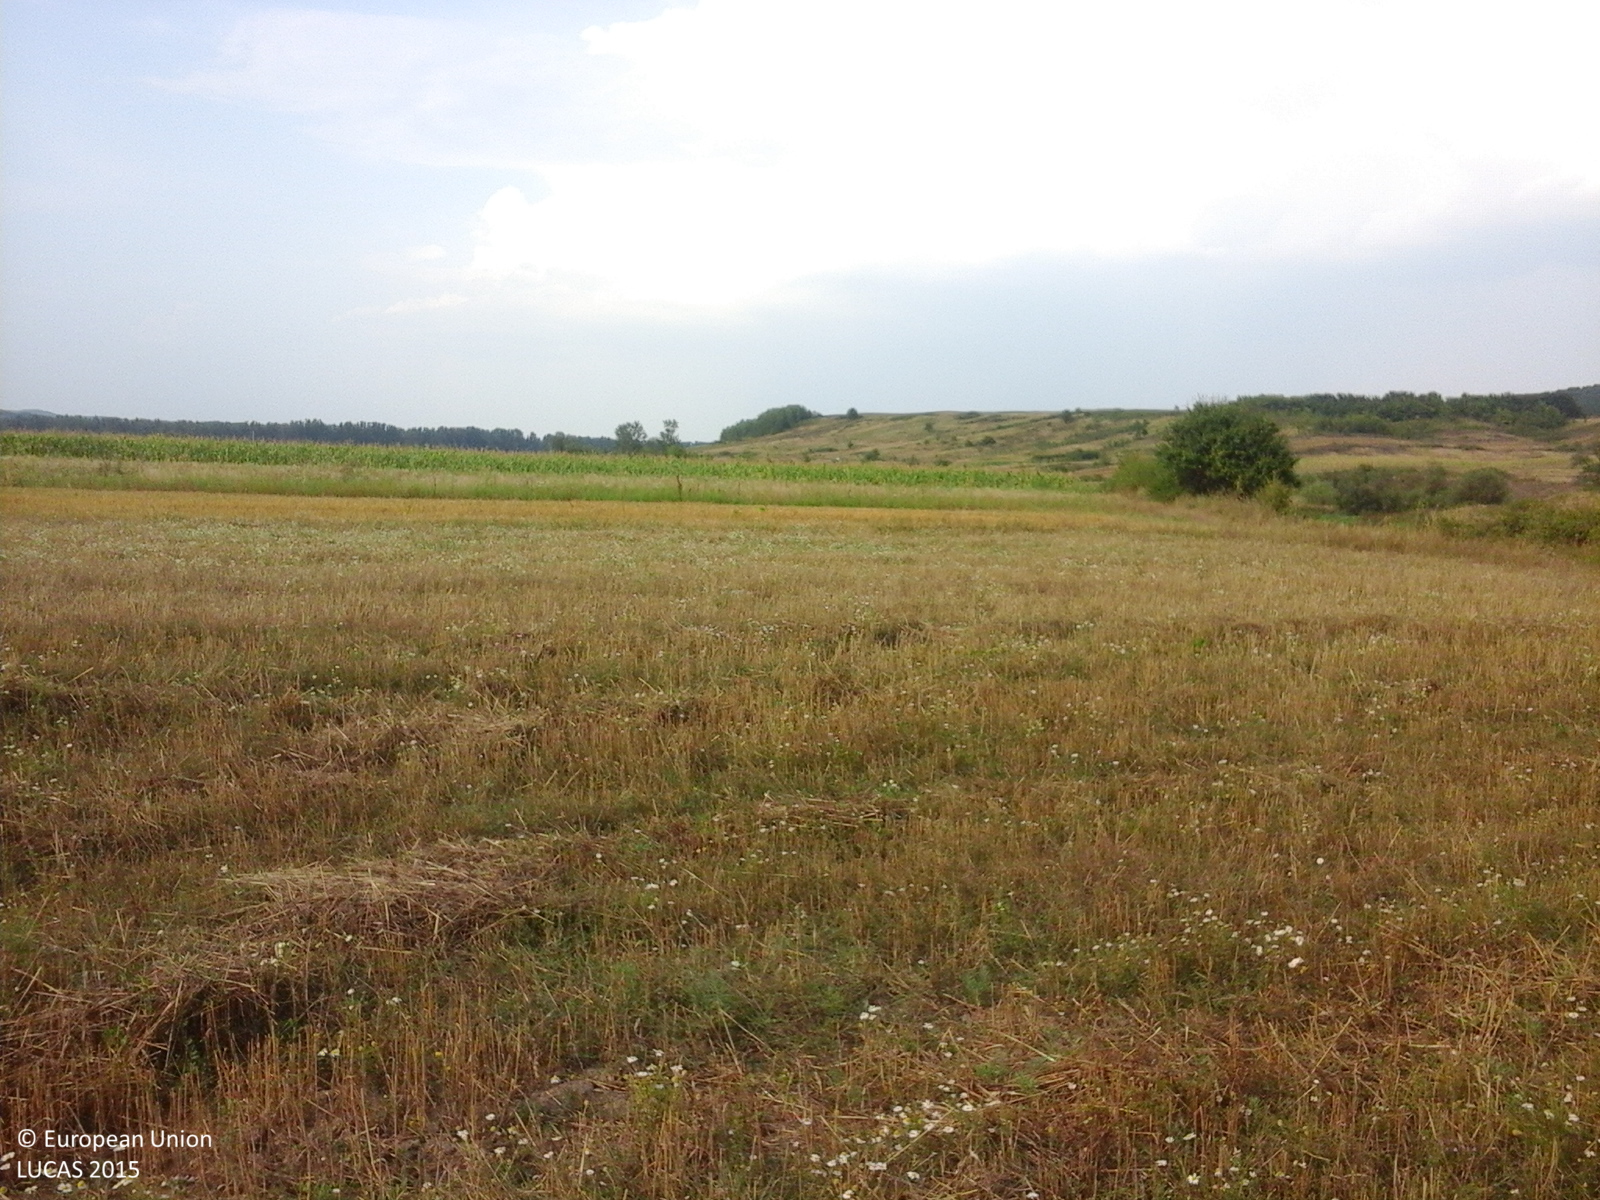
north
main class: Cropland
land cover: Common wheat
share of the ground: > 75 %
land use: Agriculture (excluding fallow land and kitchen gardens)
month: August
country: RO
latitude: 44.7252
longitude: 23.6299
